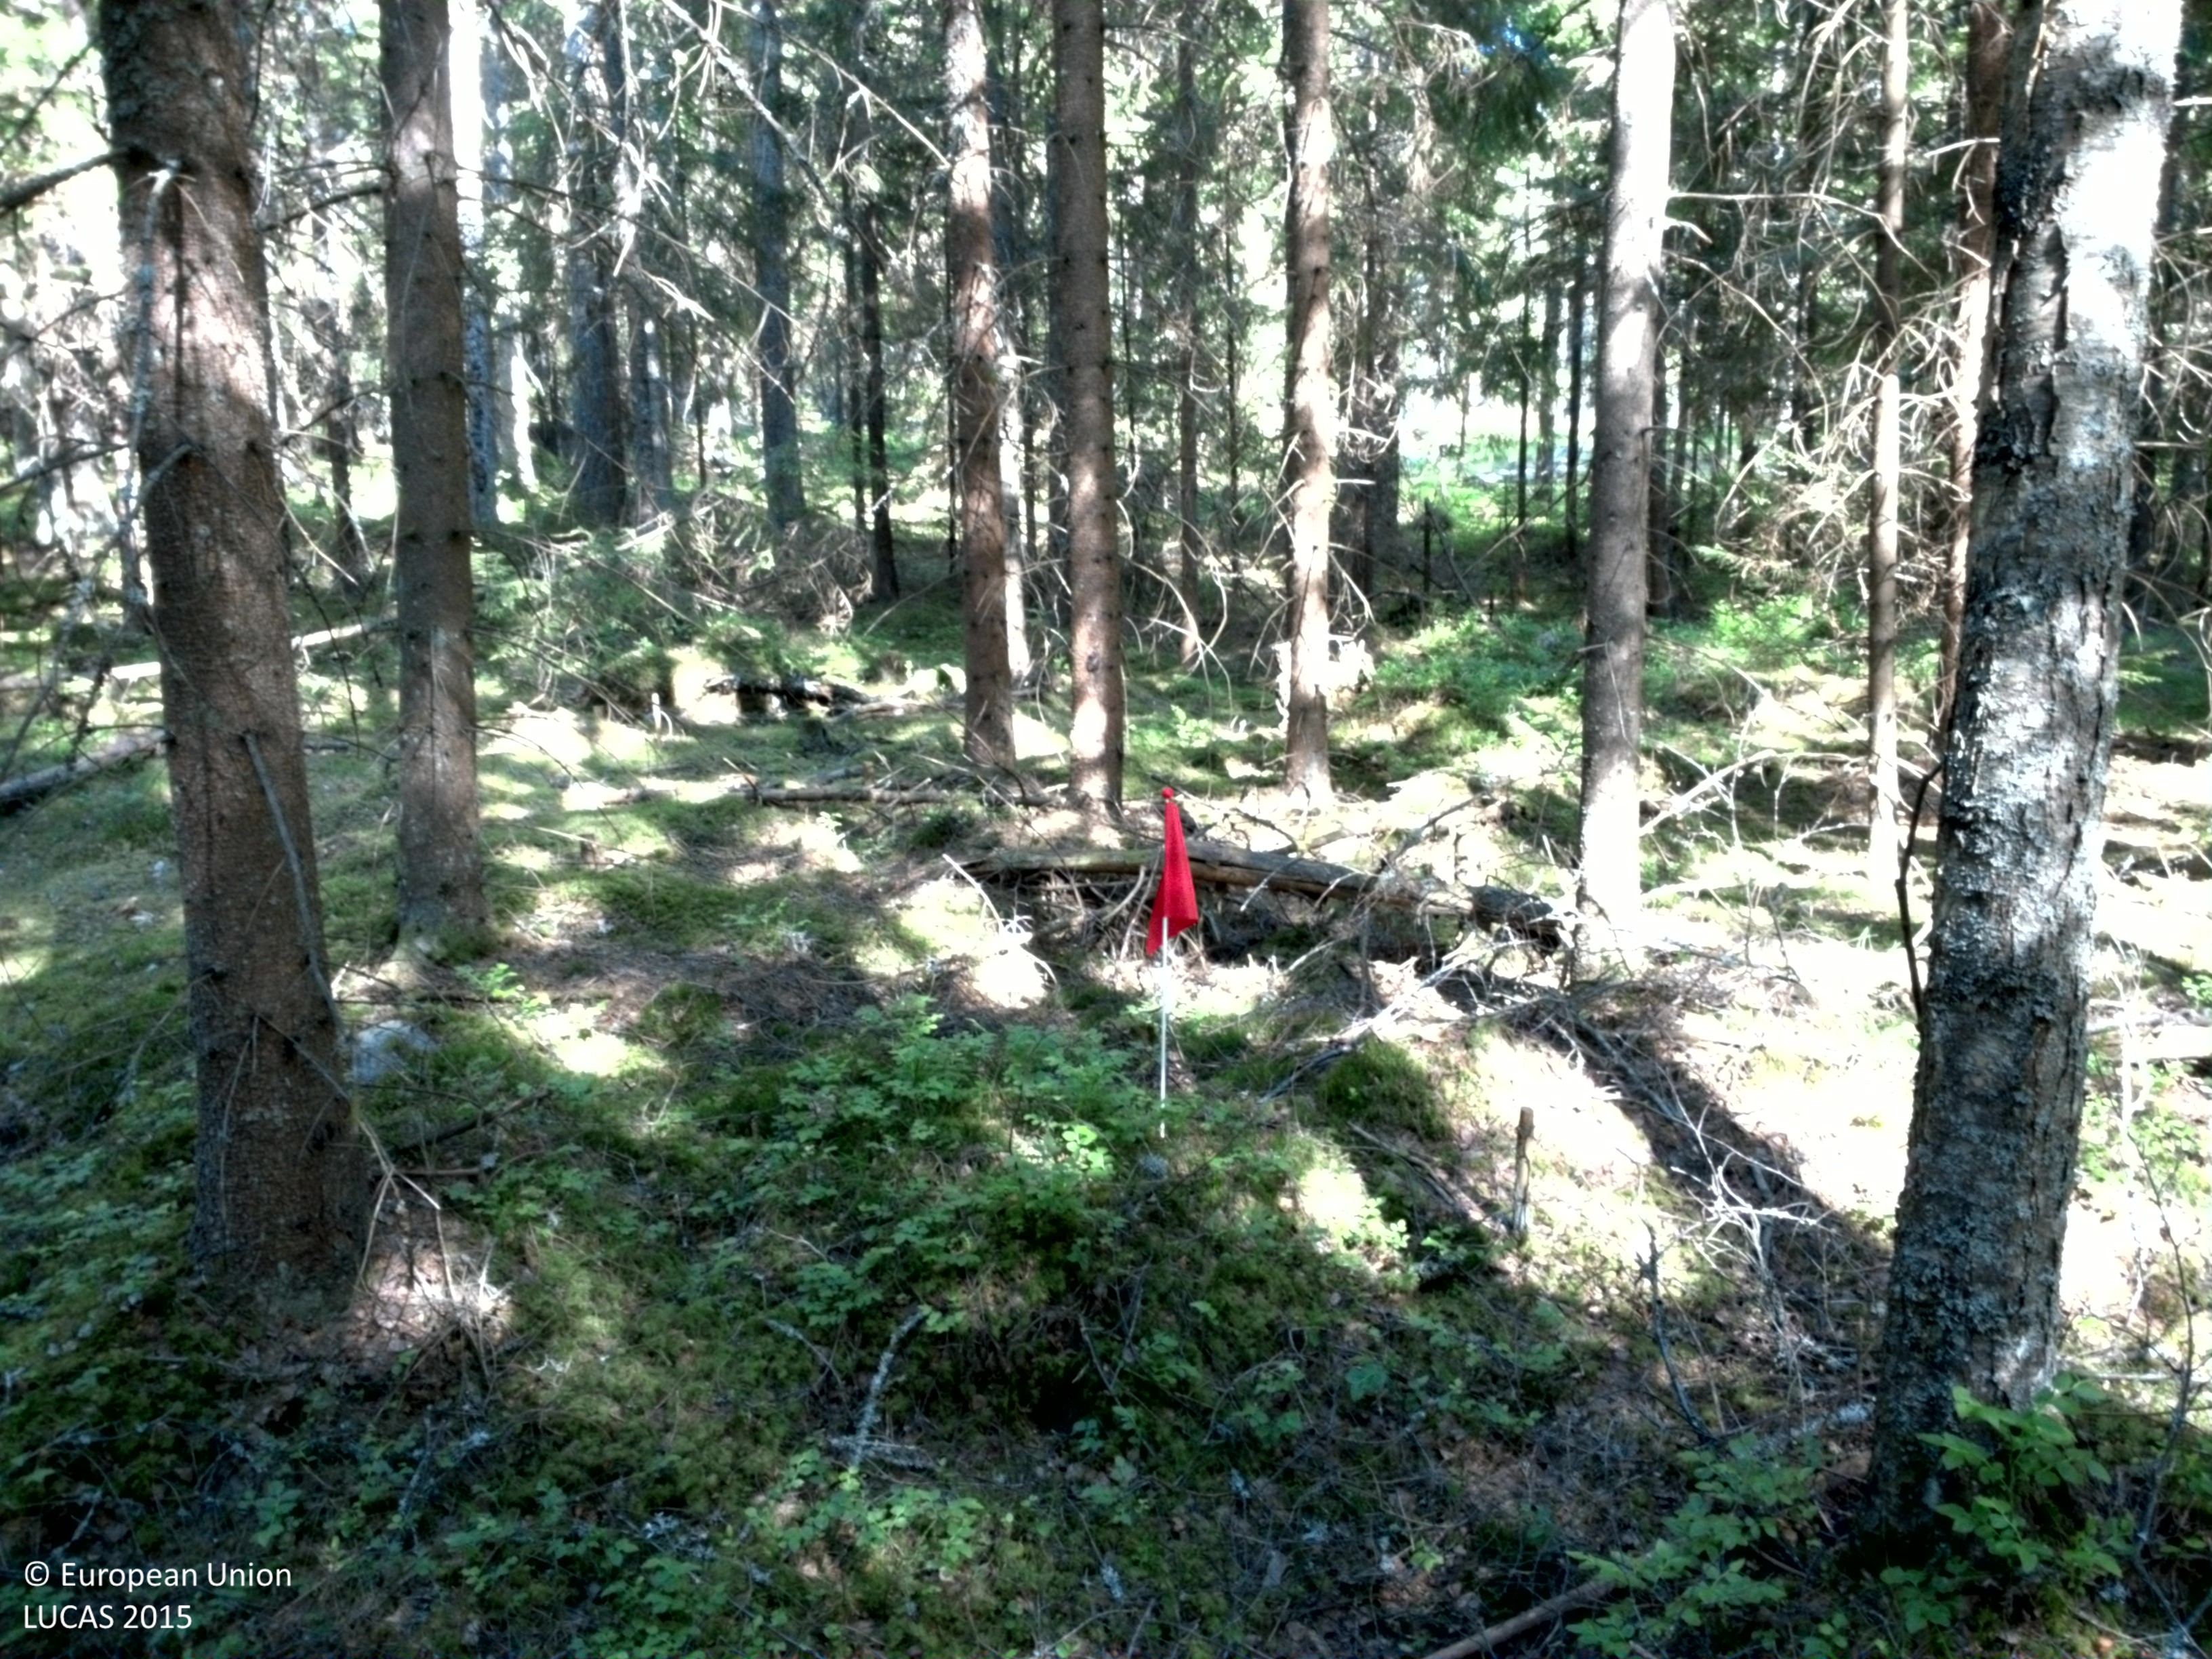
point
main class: Woodland
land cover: Spruce dominated coniferous woodland
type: boreal forest
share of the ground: > 75 %
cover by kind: coniferous forest trees 90 %, broadleaved forest trees 5 %, lichens and mosses 5 %
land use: Forestry
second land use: Community services
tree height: > 5 m
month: June
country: SE
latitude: 58.5941
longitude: 14.5183
